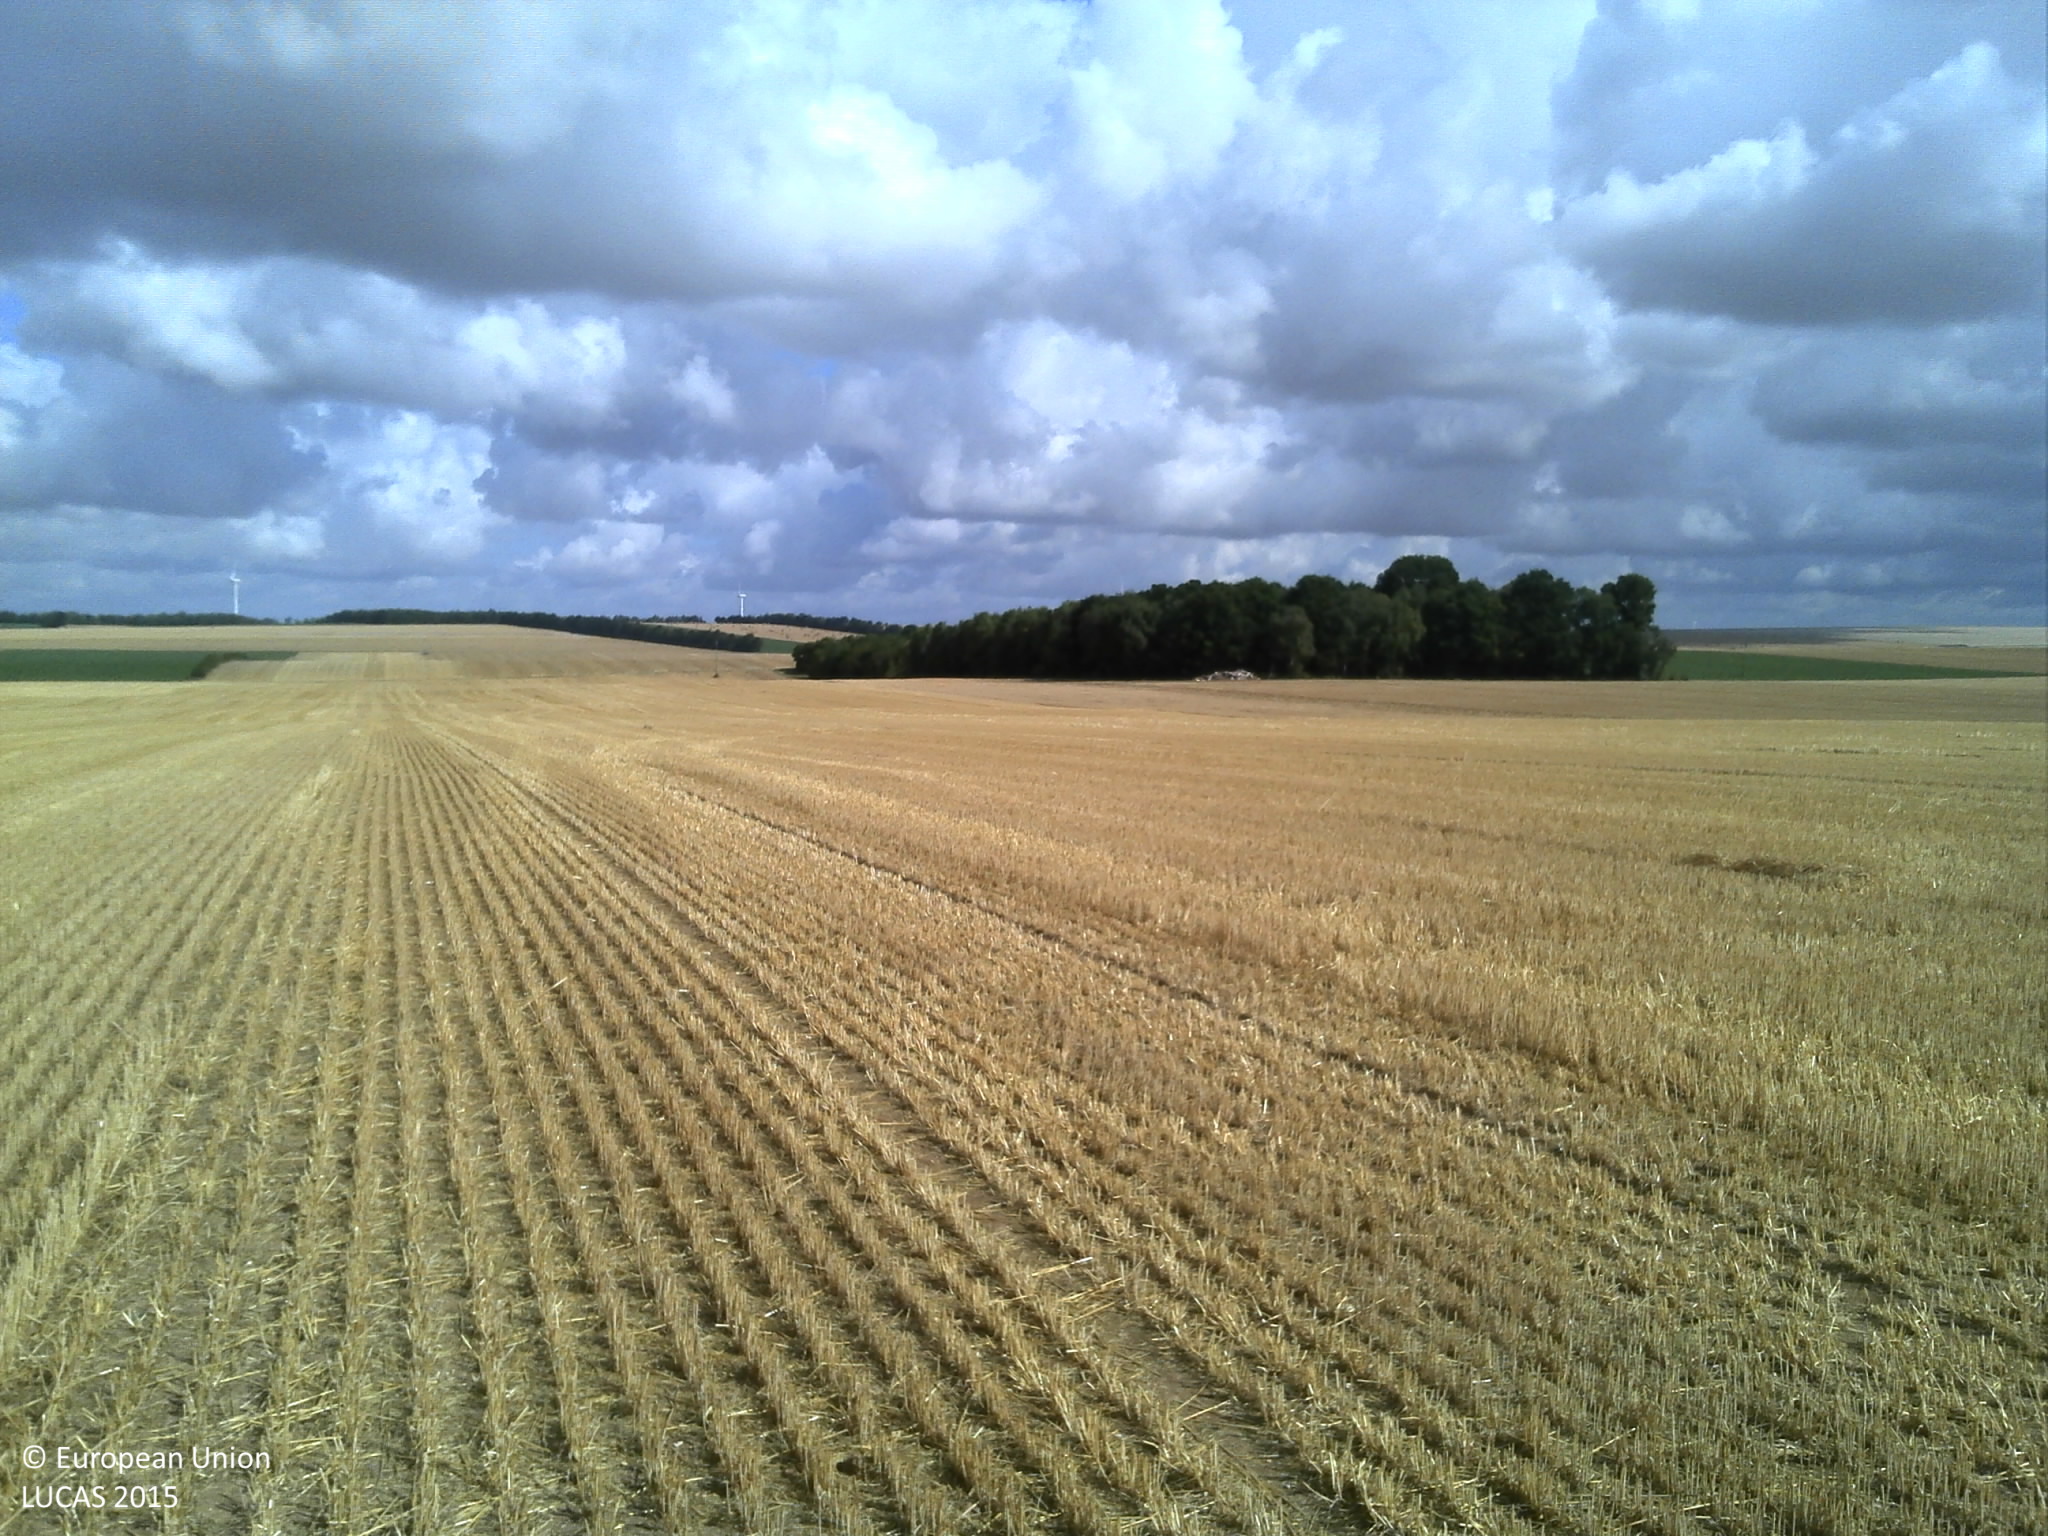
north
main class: Cropland
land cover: Barley
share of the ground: 50 - 75 %
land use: Agriculture (excluding fallow land and kitchen gardens)
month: July
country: FR
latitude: 49.3142
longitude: 4.5354
